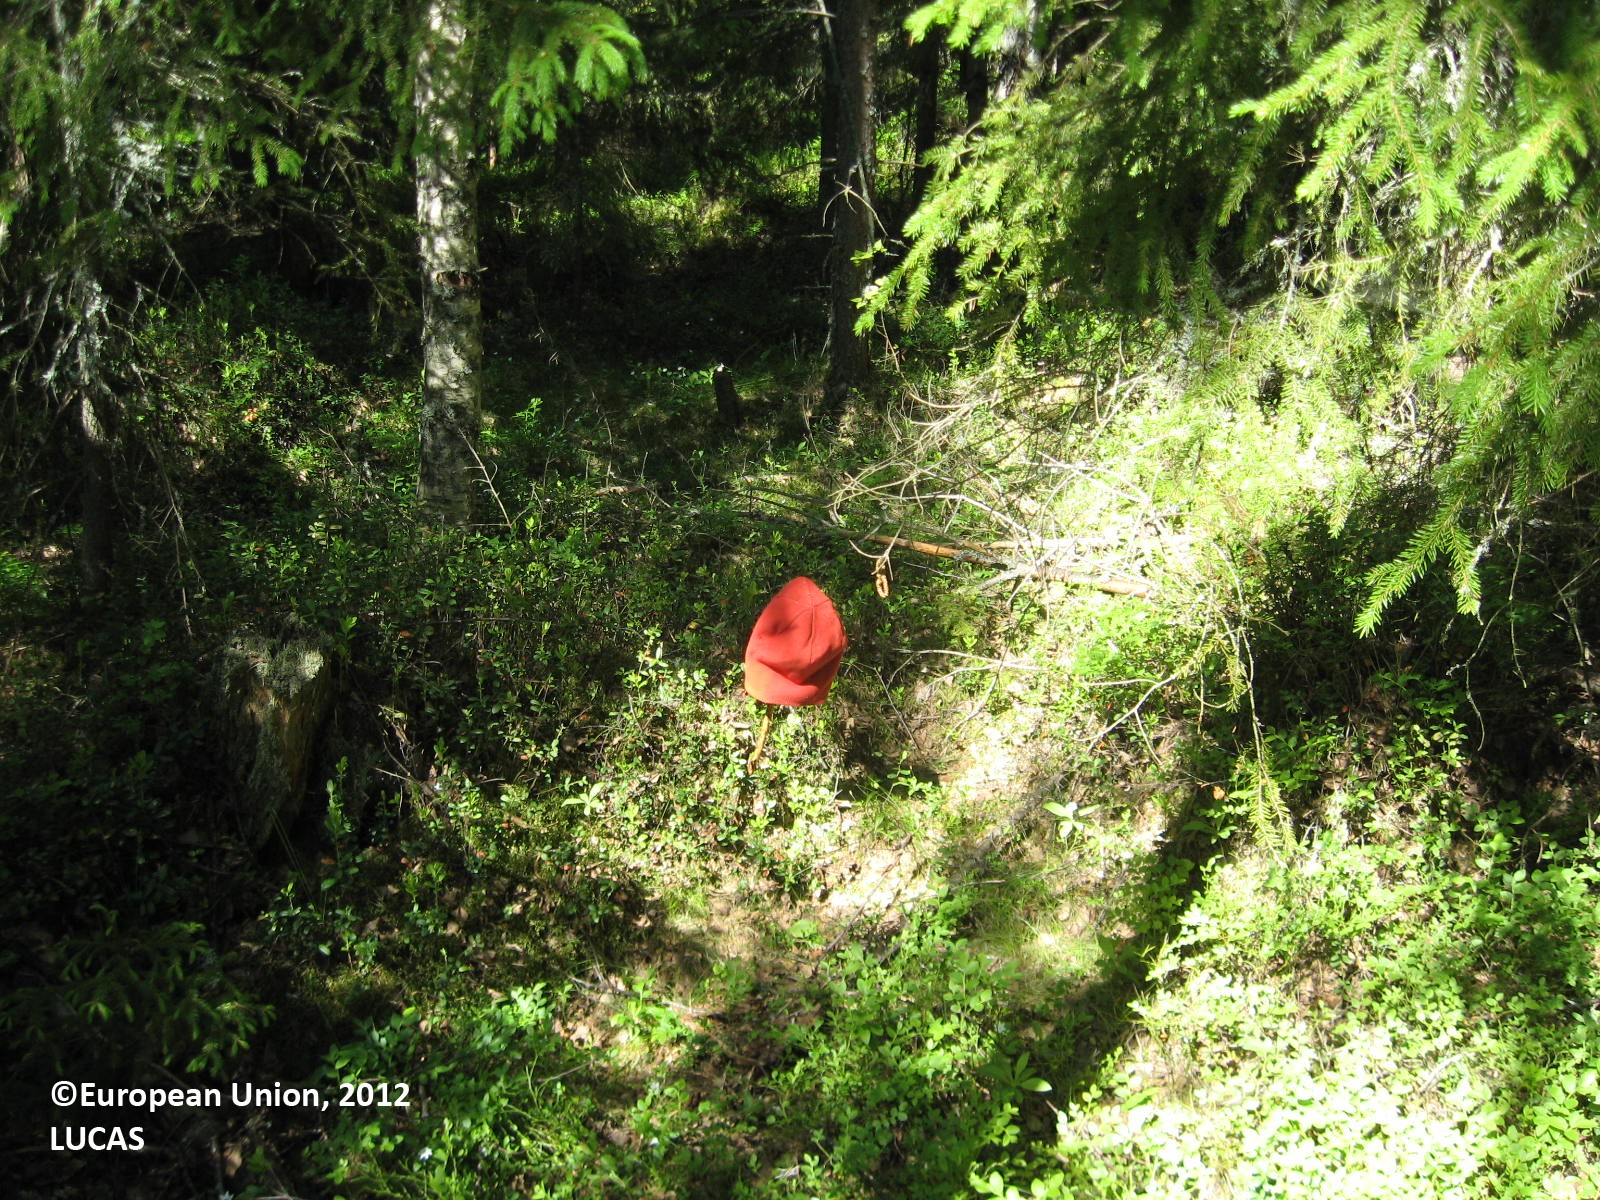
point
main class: Woodland
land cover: Spruce dominated mixed woodland
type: boreal forest
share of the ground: > 75 %
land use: Forestry
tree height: > 5 m
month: June
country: FI
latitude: 62.8049
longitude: 21.3166
